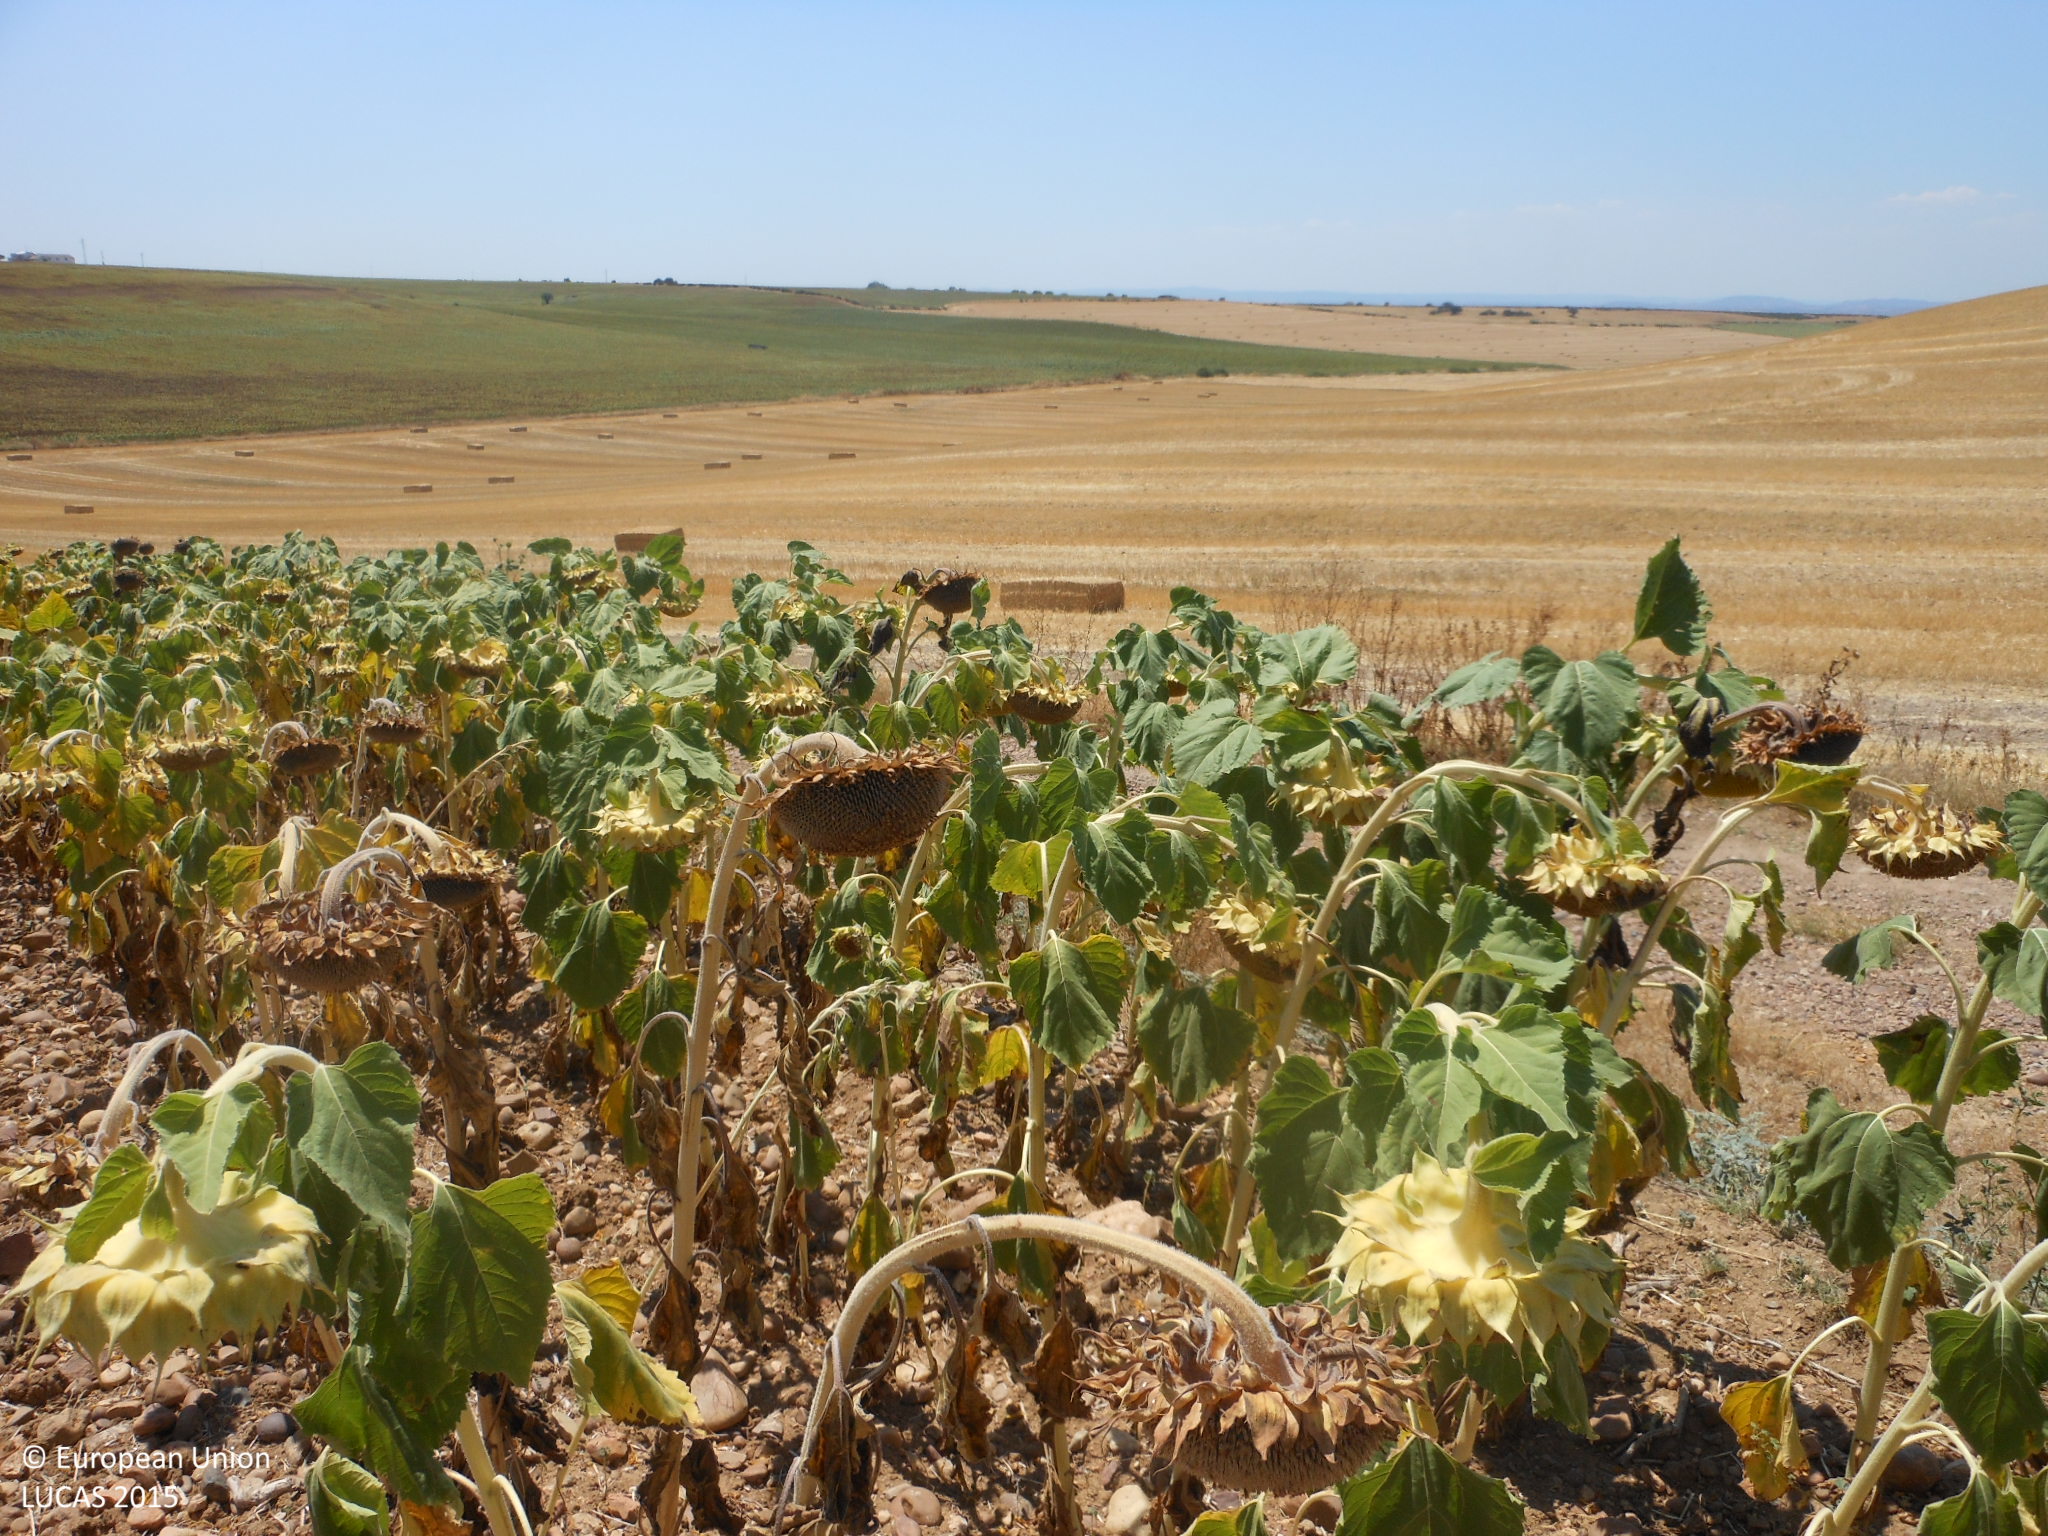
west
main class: Cropland
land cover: Sunflower
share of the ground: > 75 %
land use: Agriculture (excluding fallow land and kitchen gardens)
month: June
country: ES
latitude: 37.5489
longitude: -5.5377
